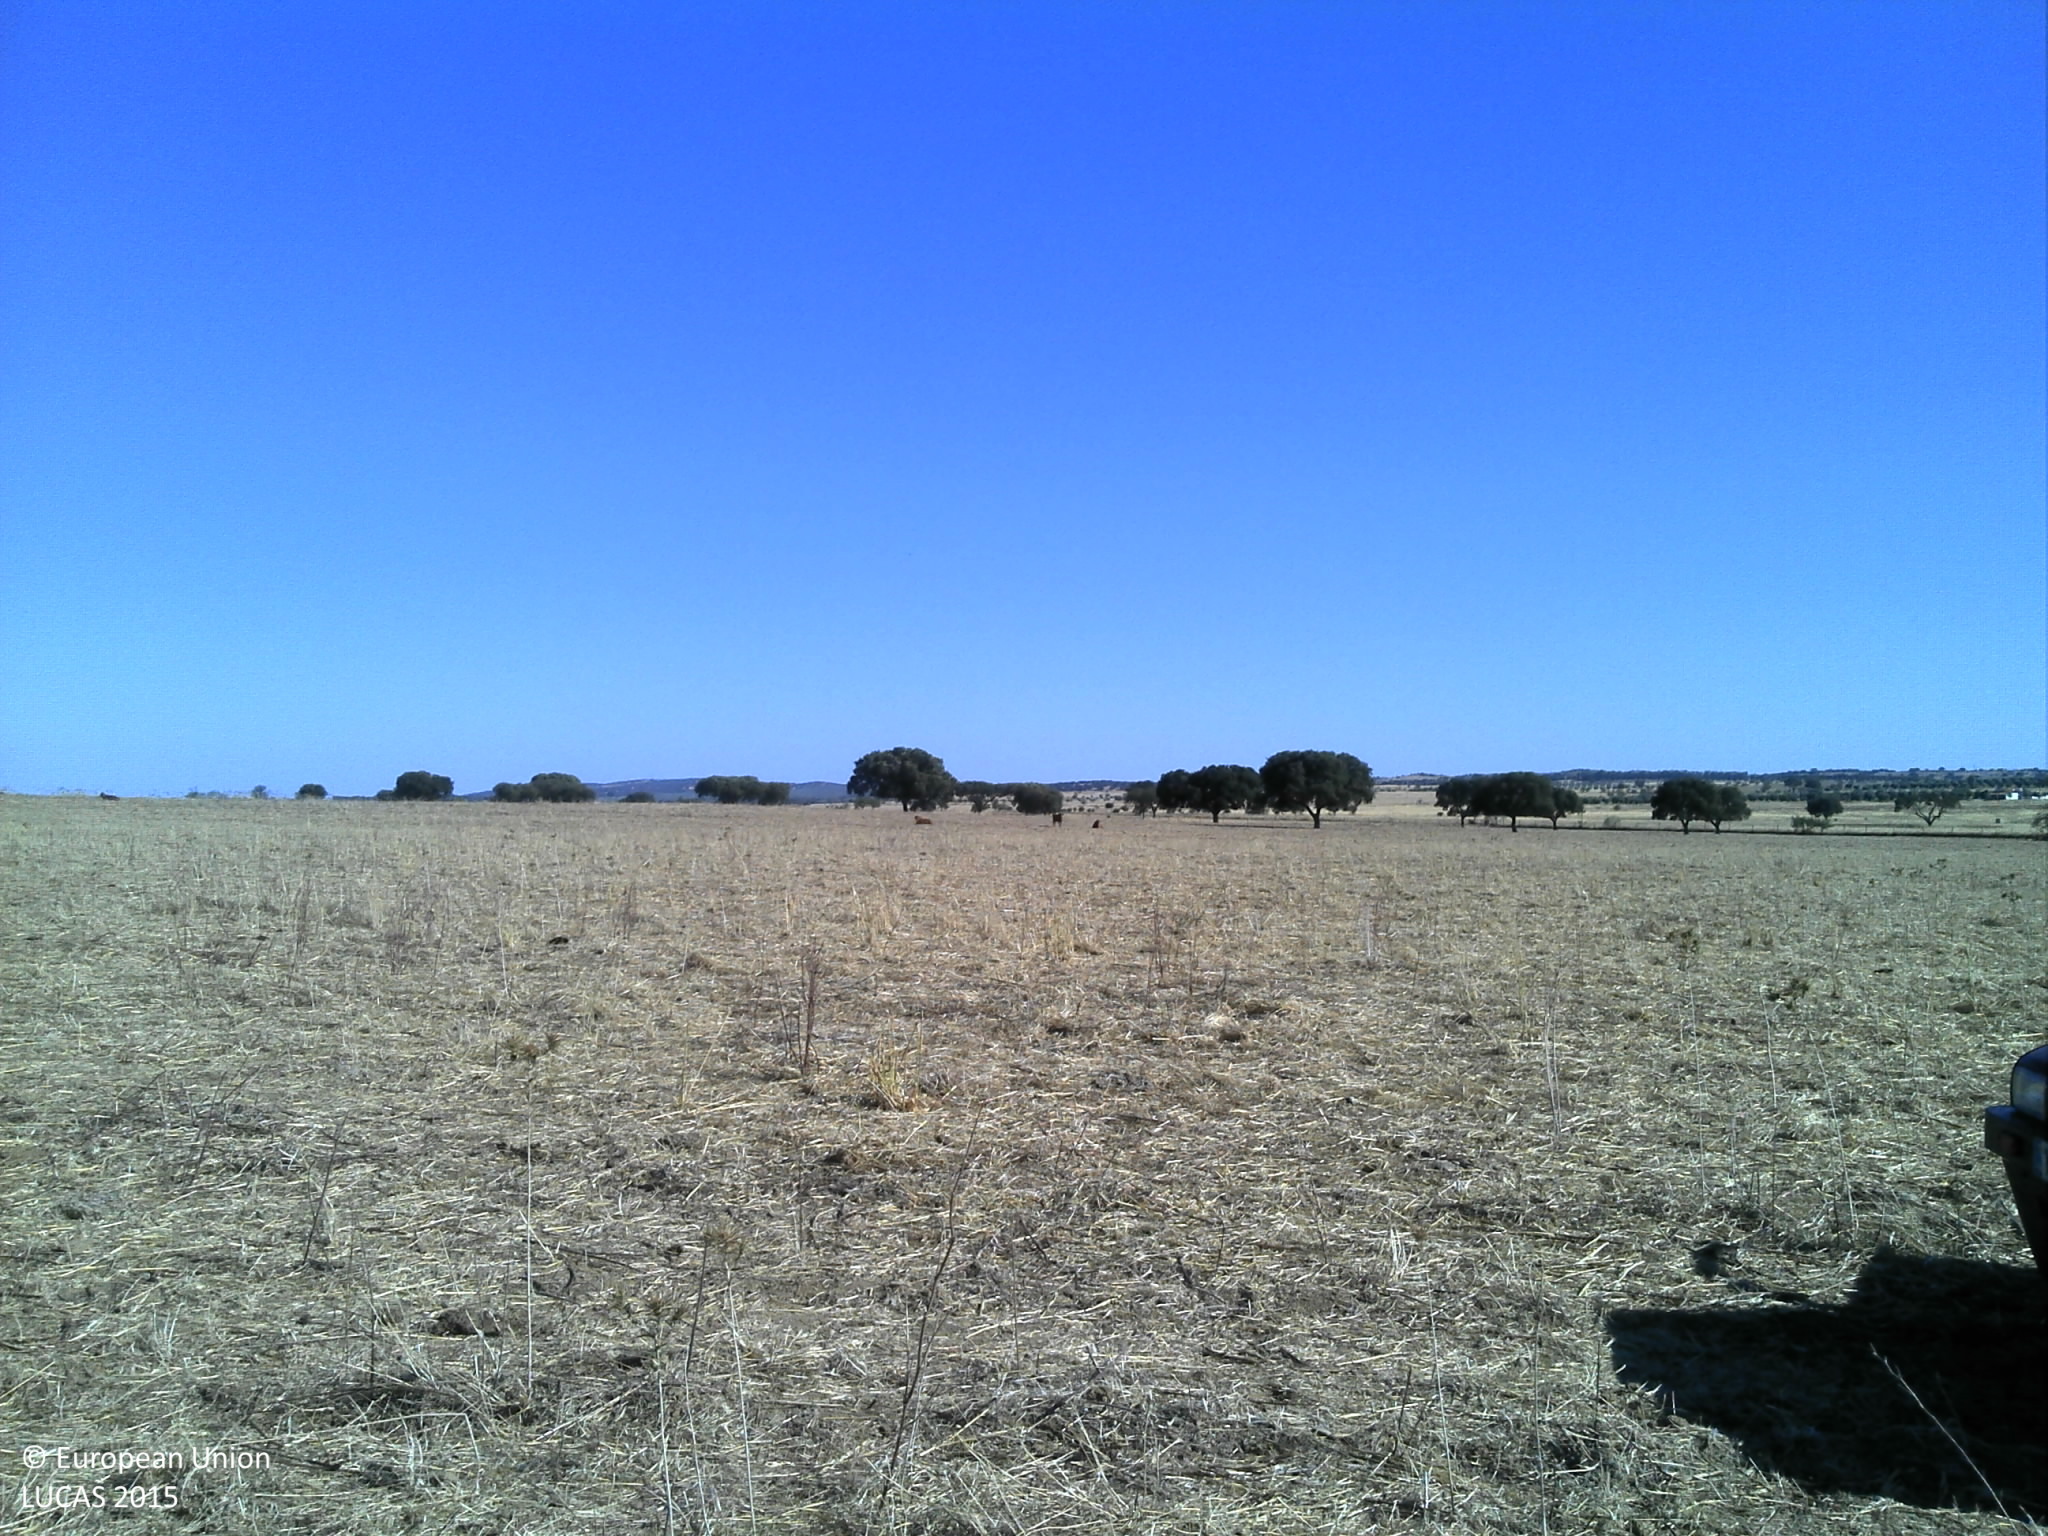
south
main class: Grassland
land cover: Grassland without tree/shrub cover
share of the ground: 10 - 25 %
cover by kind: unconsolidated bare surface 80 %, herbaceous plants 20 %
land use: Agriculture (excluding fallow land and kitchen gardens)
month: July
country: PT
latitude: 38.9799
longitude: -7.4790
